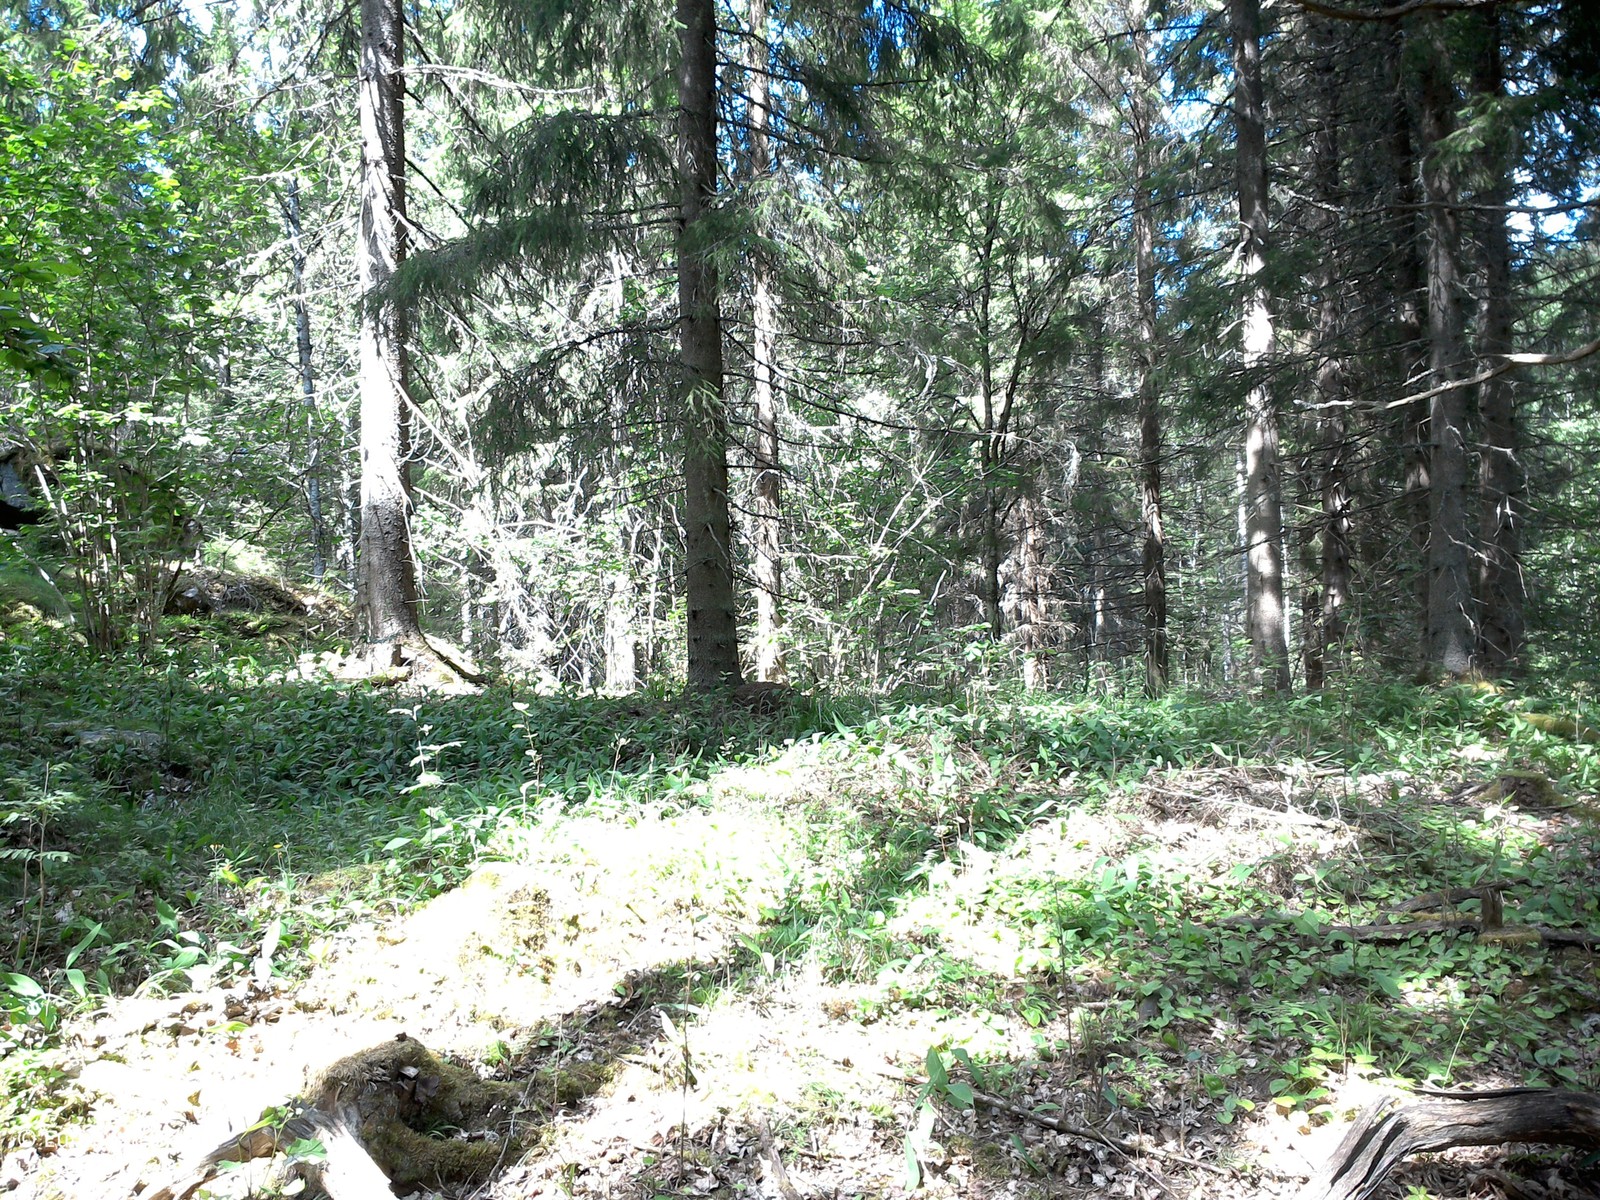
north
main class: Woodland
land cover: Spruce dominated mixed woodland
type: boreal forest
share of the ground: 50 - 75 %
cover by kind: coniferous forest trees 50 %, broadleaved forest trees 20 %, herbaceous plants 20 %, shrubs 10 %
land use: Forestry
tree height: > 5 m
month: July
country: SE
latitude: 58.0453
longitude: 14.7550
